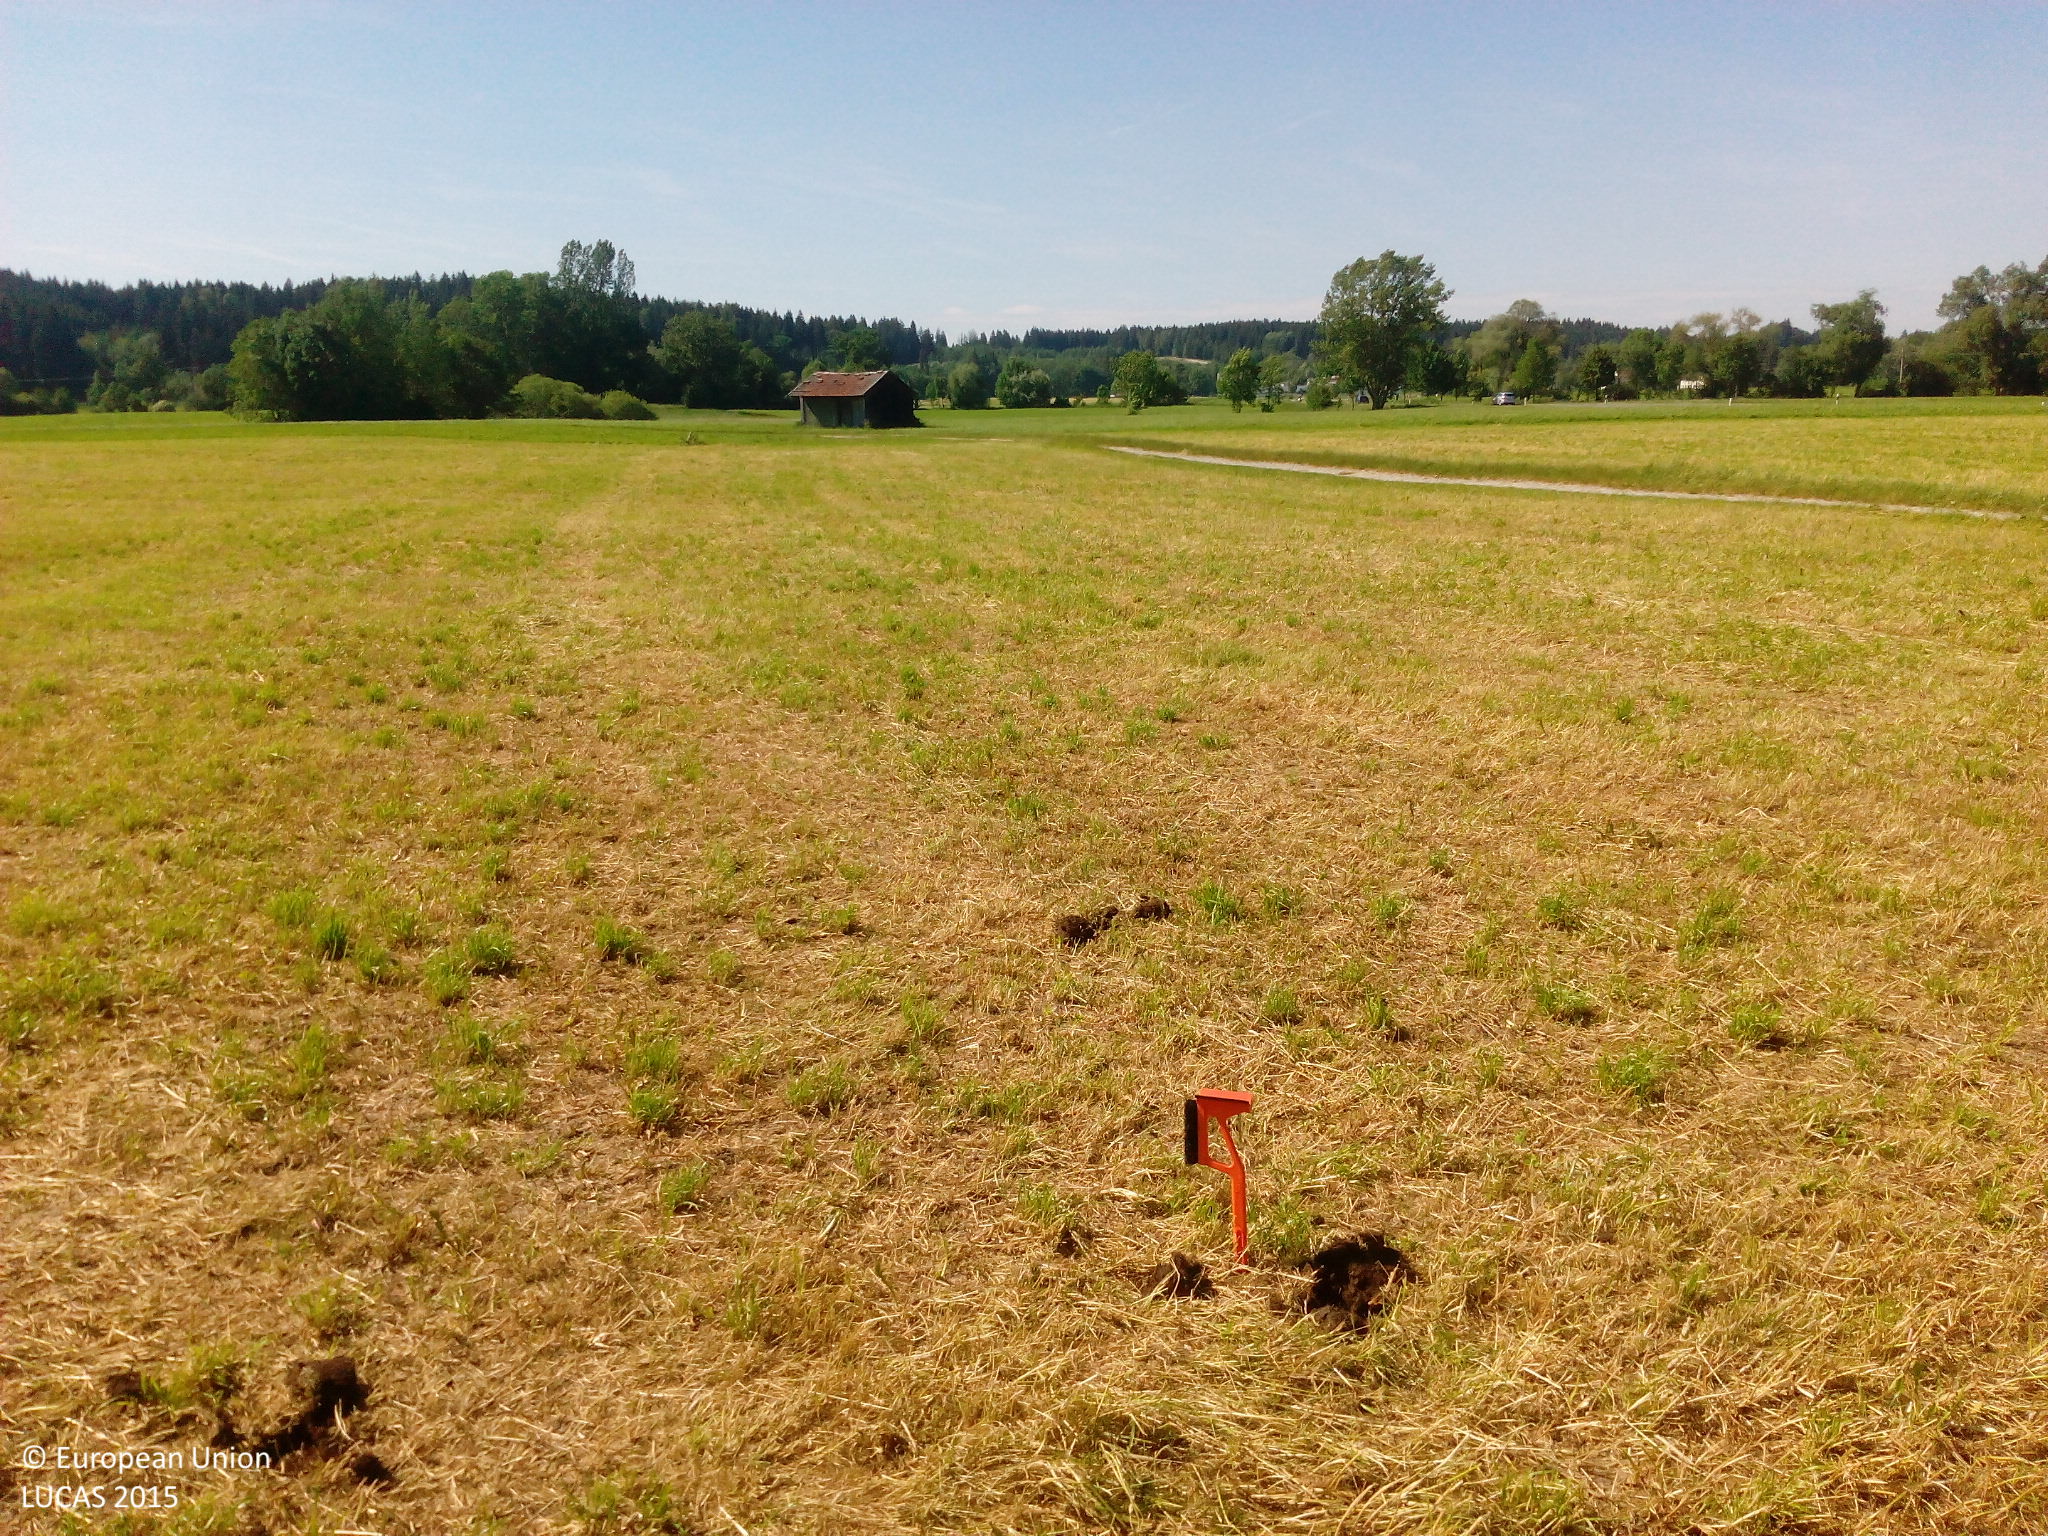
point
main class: Grassland
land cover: Grassland without tree/shrub cover
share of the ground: > 75 %
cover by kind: herbaceous plants 100 %
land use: Agriculture (excluding fallow land and kitchen gardens)
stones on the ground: < 10 %
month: June
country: DE
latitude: 47.9160
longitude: 10.6017
